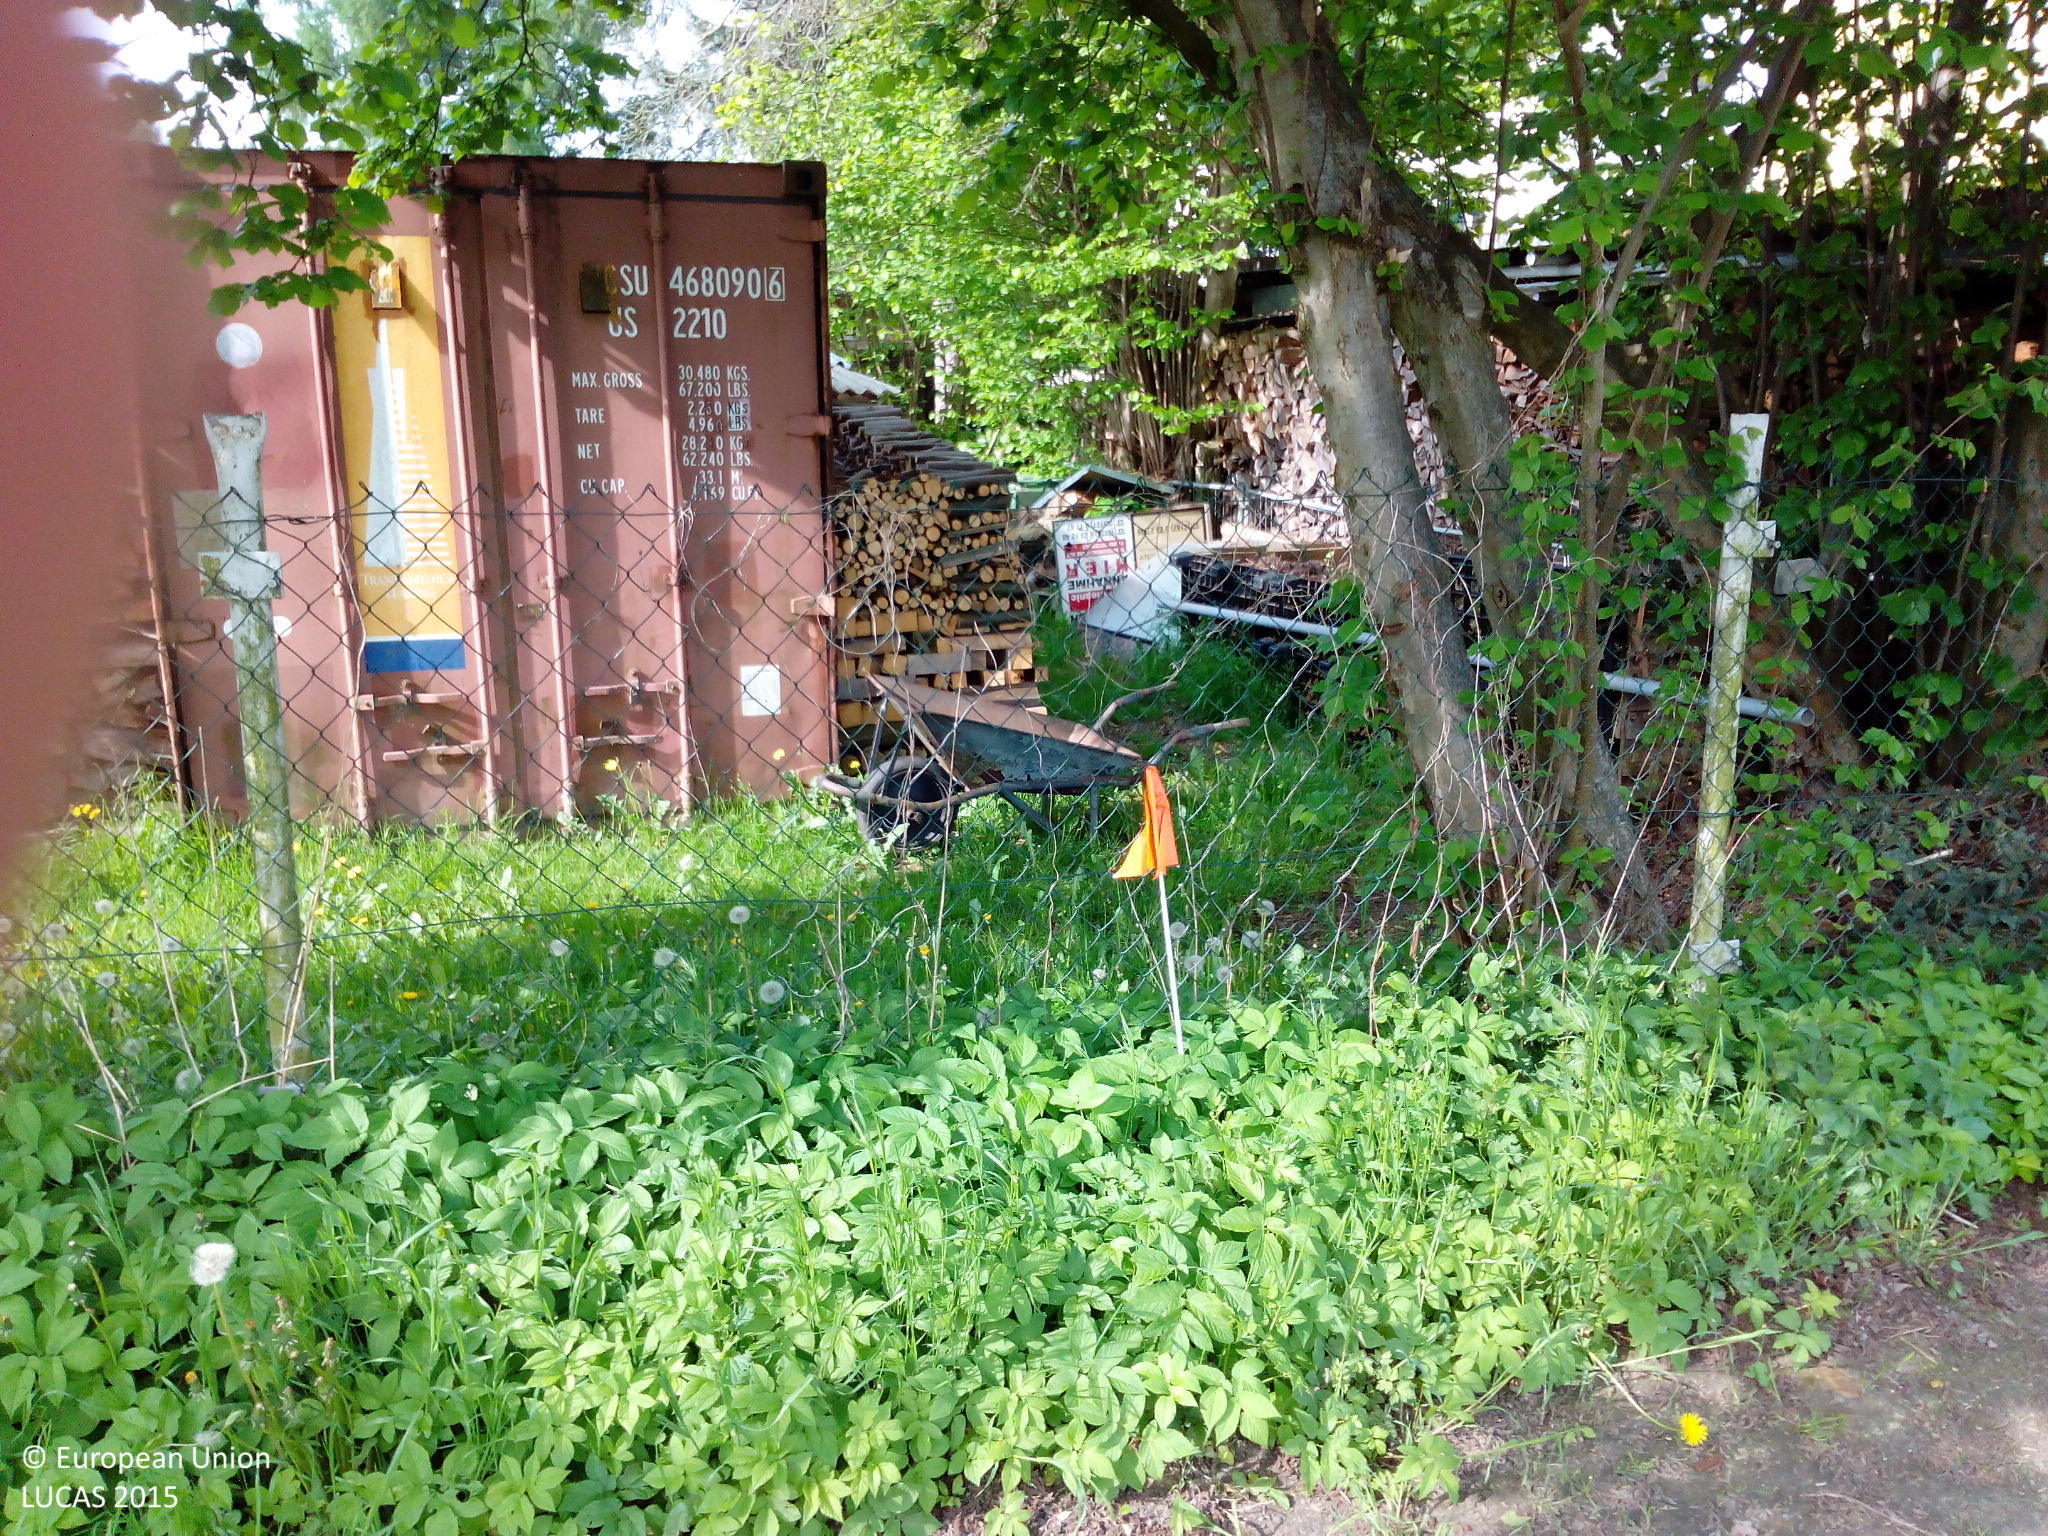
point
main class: Woodland
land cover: Broadleaved woodland
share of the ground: 10 - 25 %
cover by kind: consolidated bare surface 55 %, herbaceous plants 25 %, broadleaved forest trees 20 %
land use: Residential
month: May
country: DE
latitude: 50.8444
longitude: 13.0819
